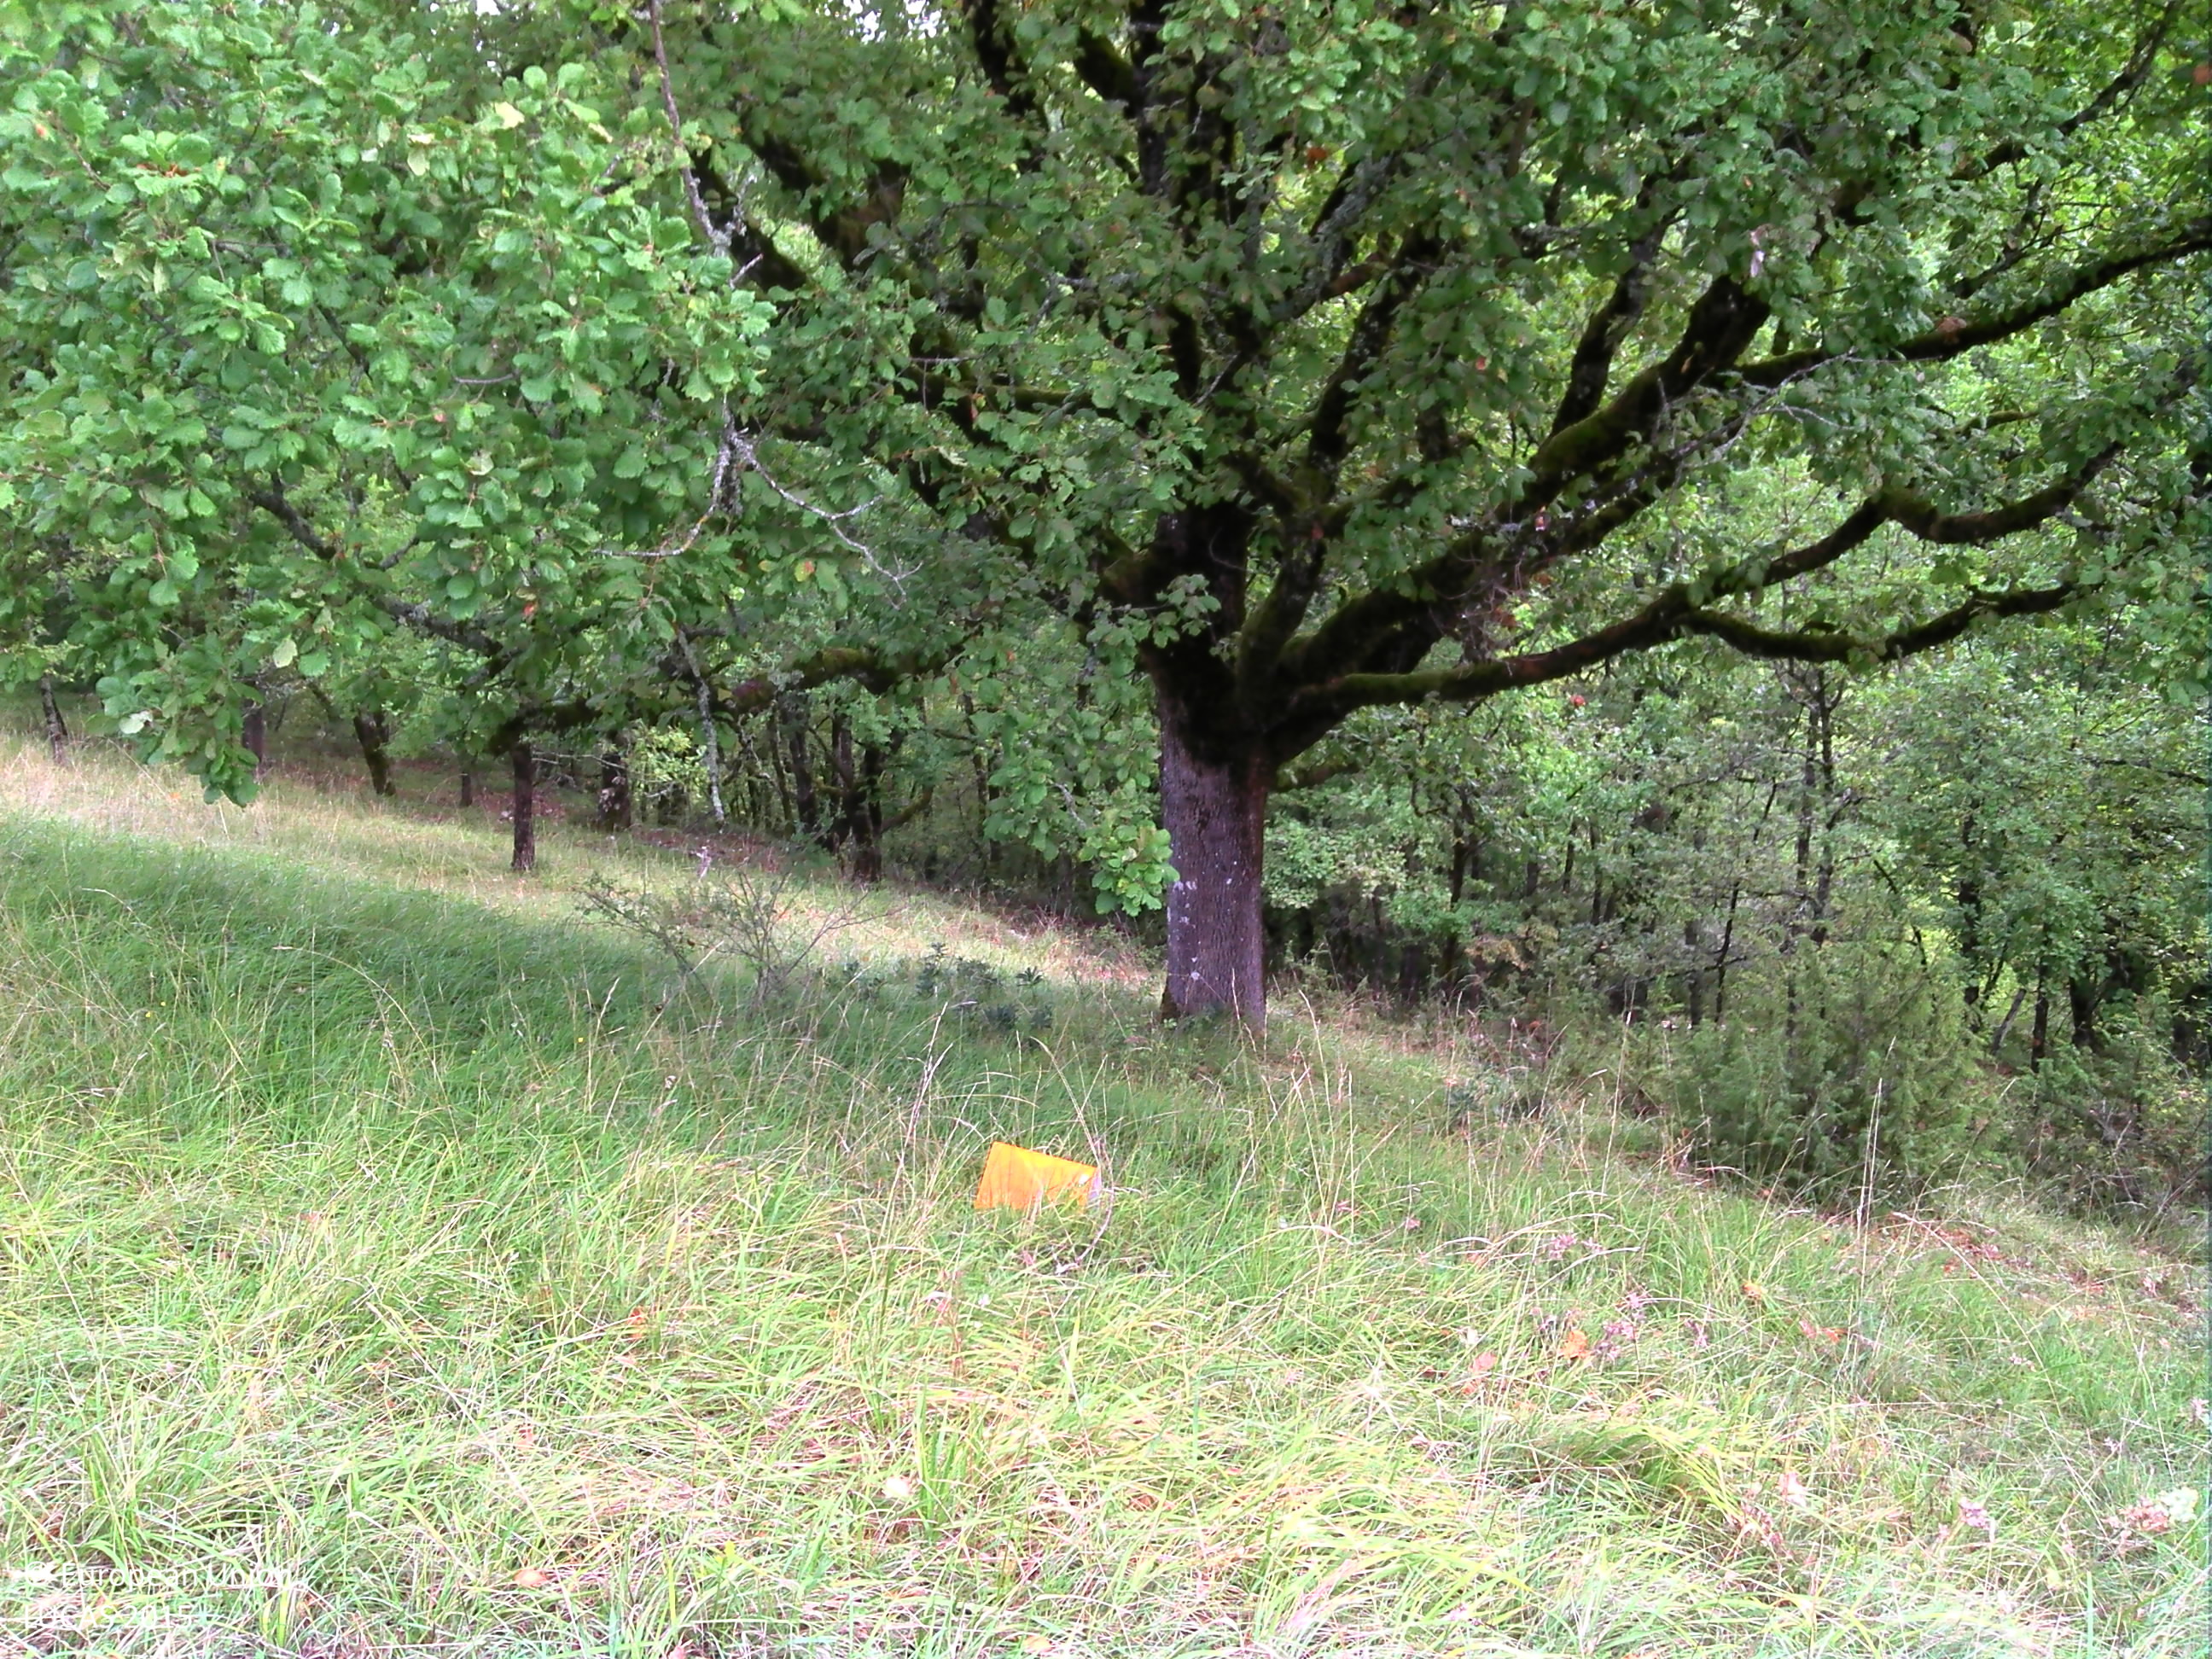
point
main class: Woodland
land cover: Broadleaved woodland
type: mesophytic deciduous forest
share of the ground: 50 - 75 %
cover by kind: broadleaved forest trees 60 %, herbaceous plants 30 %, shrubs 10 %
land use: Forestry
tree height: > 5 m
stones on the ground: < 10 %
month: September
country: FR
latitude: 44.5990
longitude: 1.4938
